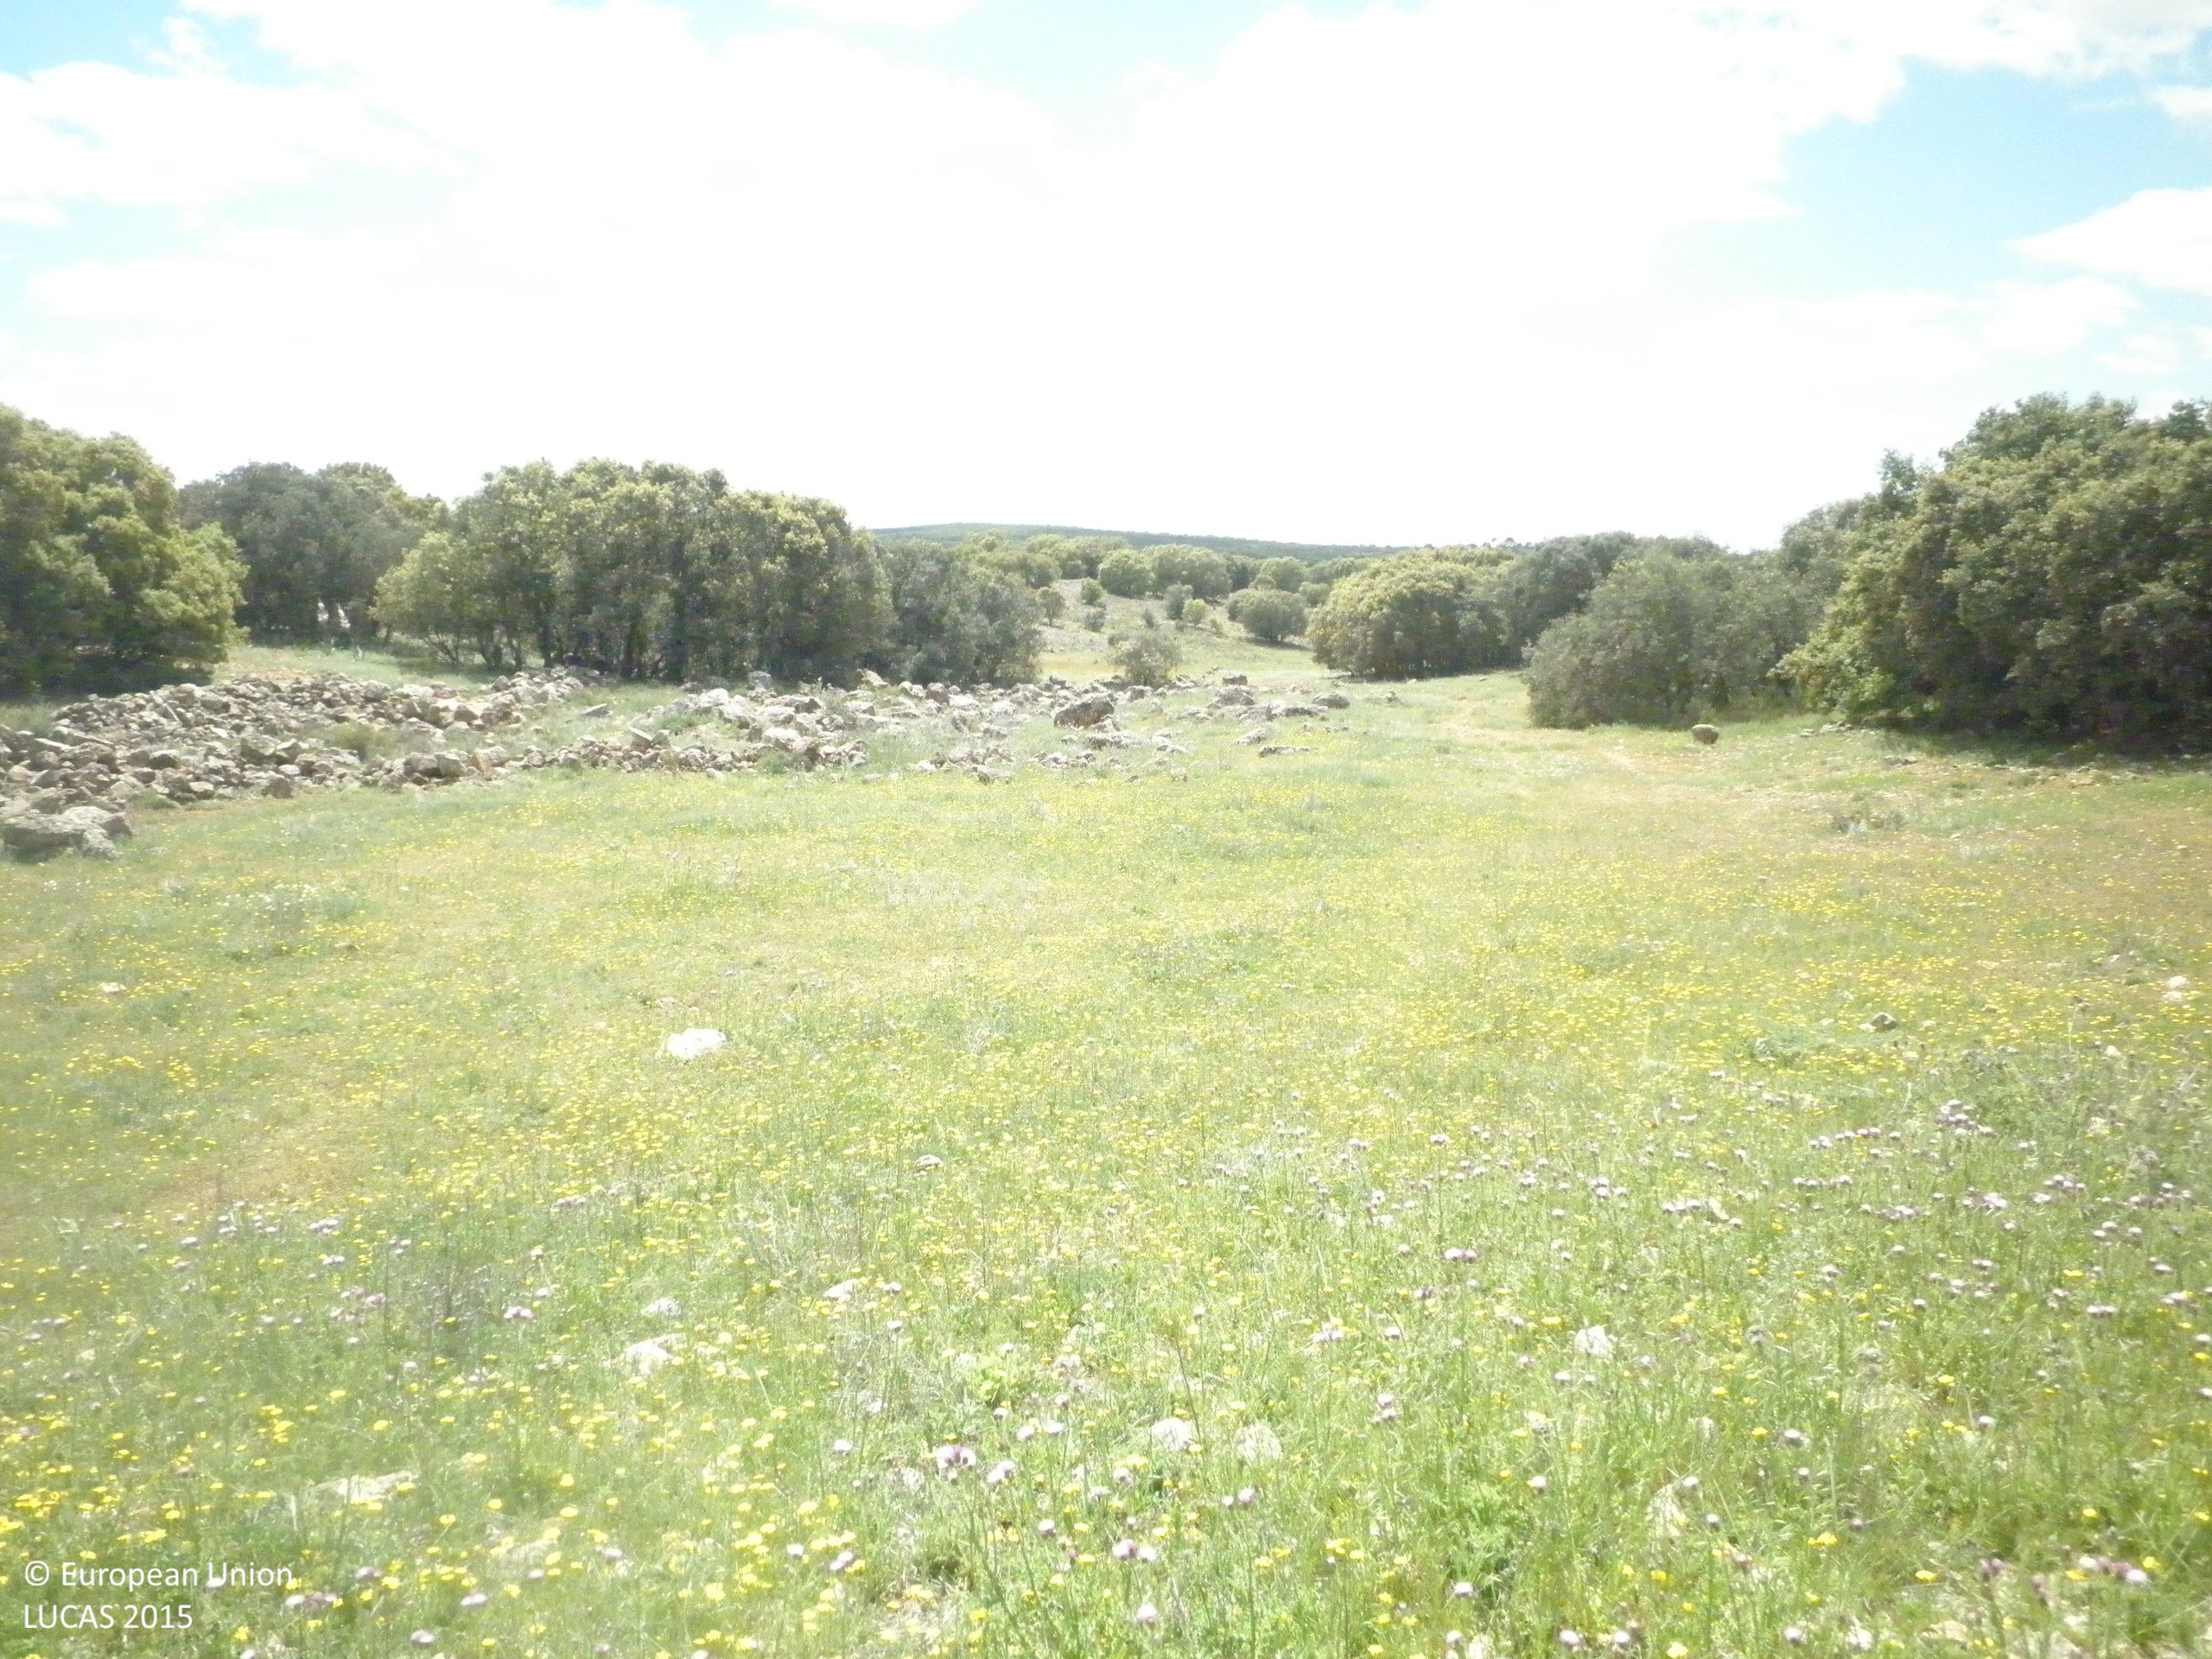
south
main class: Grassland
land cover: Spontaneously vegetated surfaces
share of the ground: > 75 %
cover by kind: herbaceous plants 60 %, unconsolidated bare surface 35 %, shrubs 5 %
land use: Semi-natural and natural areas not in use
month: May
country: ES
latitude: 39.6951
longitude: -2.8340
